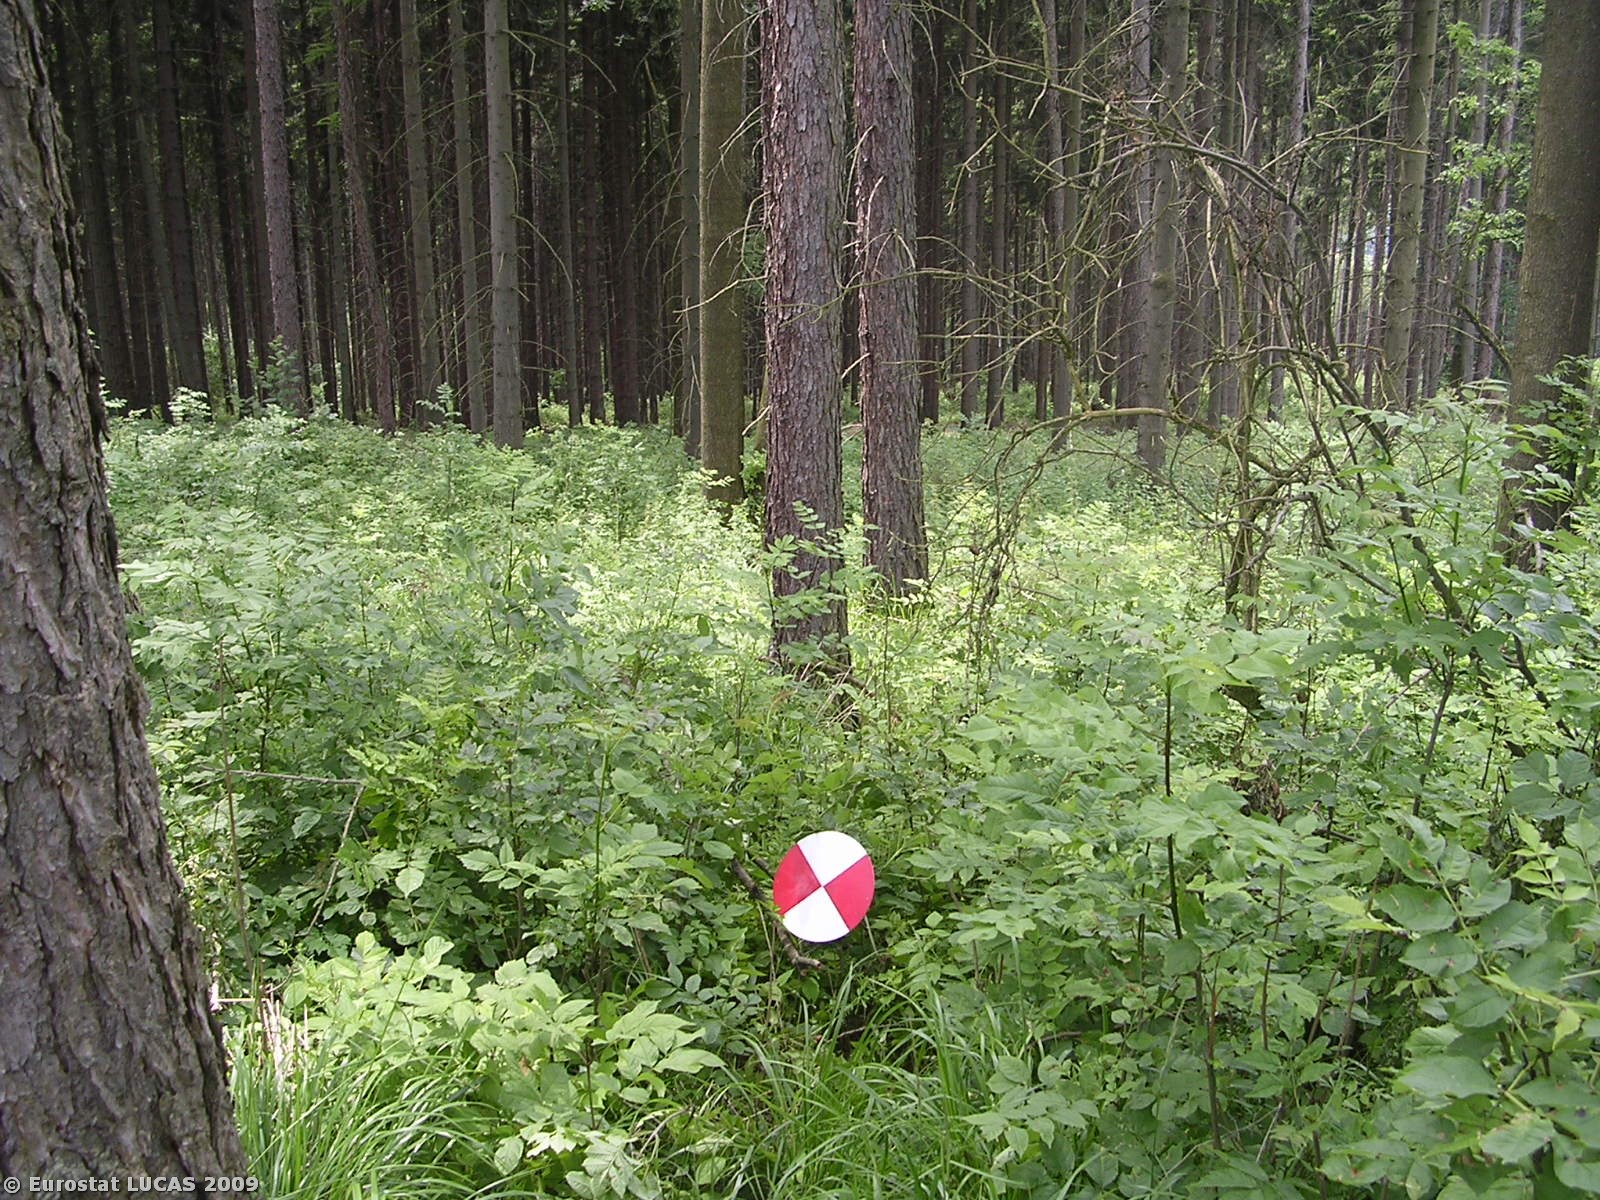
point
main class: Woodland
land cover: Mixed woodland
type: hemiboreal forest and nemoral coniferous forest and mixed broadleaved-coniferous forest
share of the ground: > 75 %
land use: Forestry
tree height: > 5 m
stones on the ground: < 10 %
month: June
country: CZ
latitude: 50.6291
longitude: 14.2000
